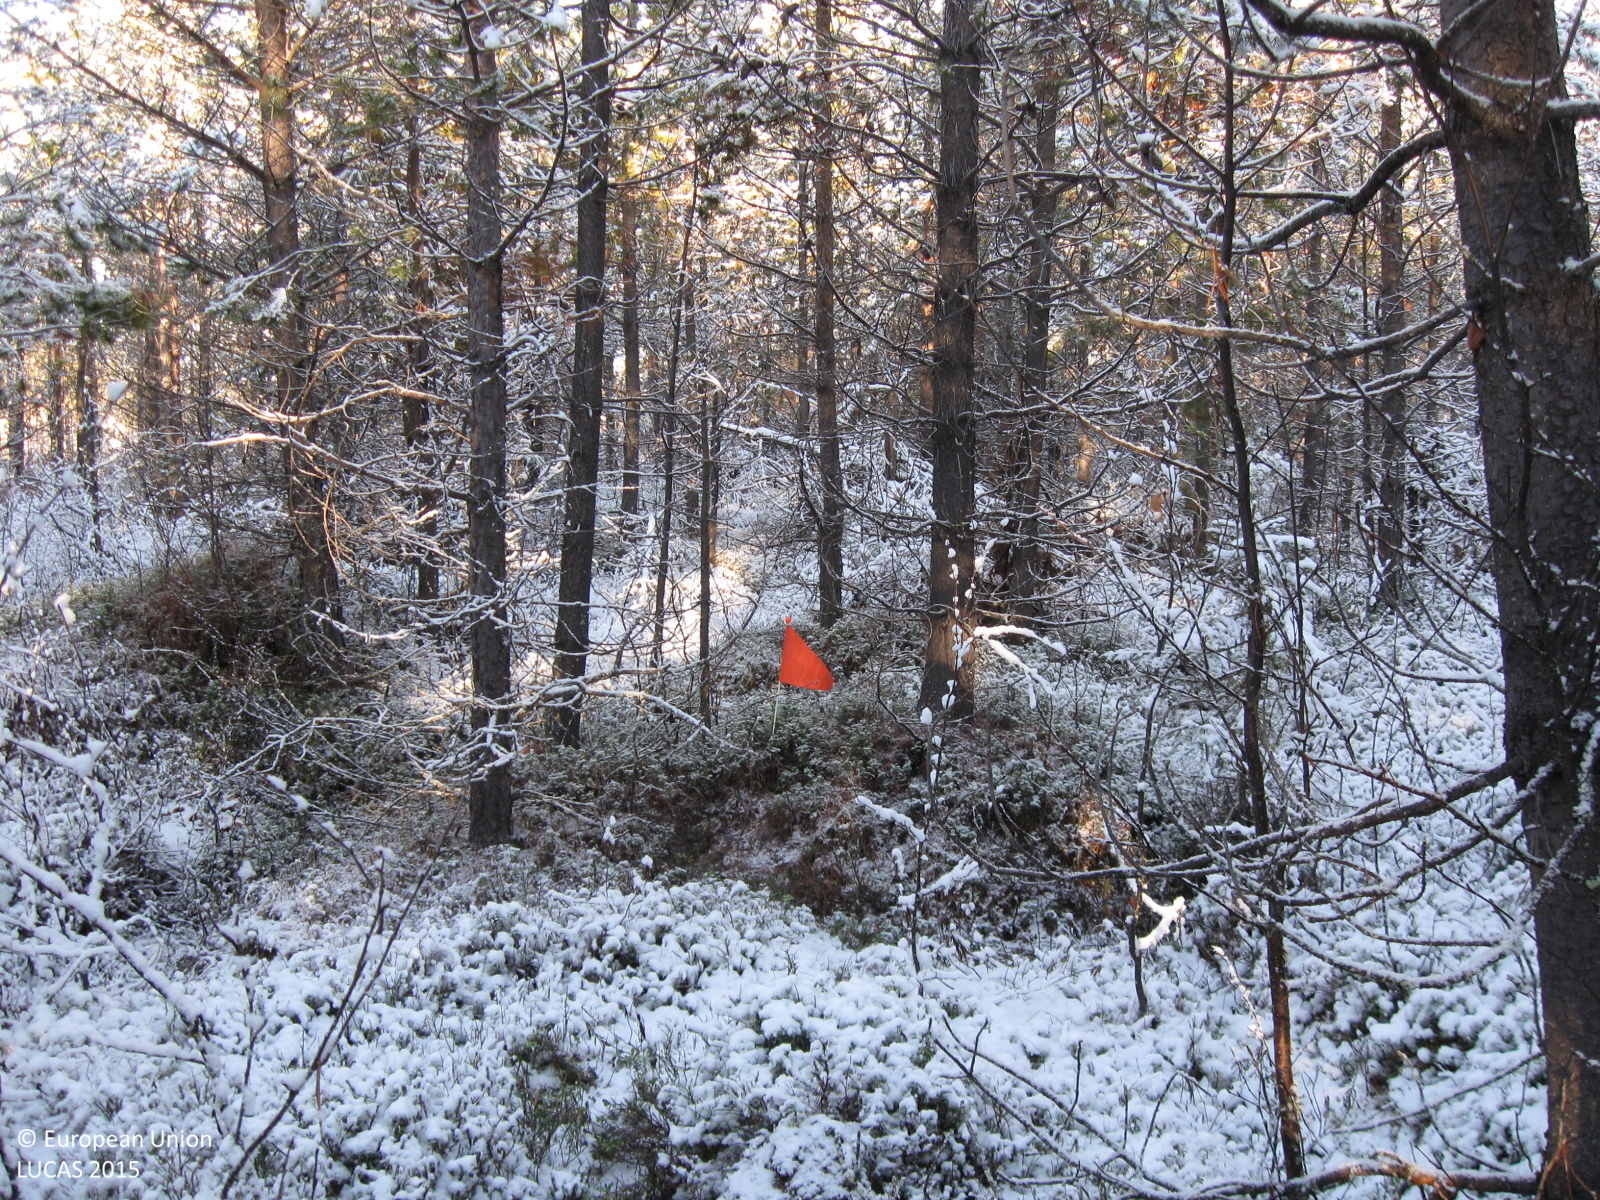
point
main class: Woodland
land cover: Pine dominated coniferous woodland
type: mire and swamp forests
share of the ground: > 75 %
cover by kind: coniferous forest trees 90 %, broadleaved forest trees 5 %, shrubs 5 %
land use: Forestry
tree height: > 5 m
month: October
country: SE
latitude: 66.4023
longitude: 21.4024
